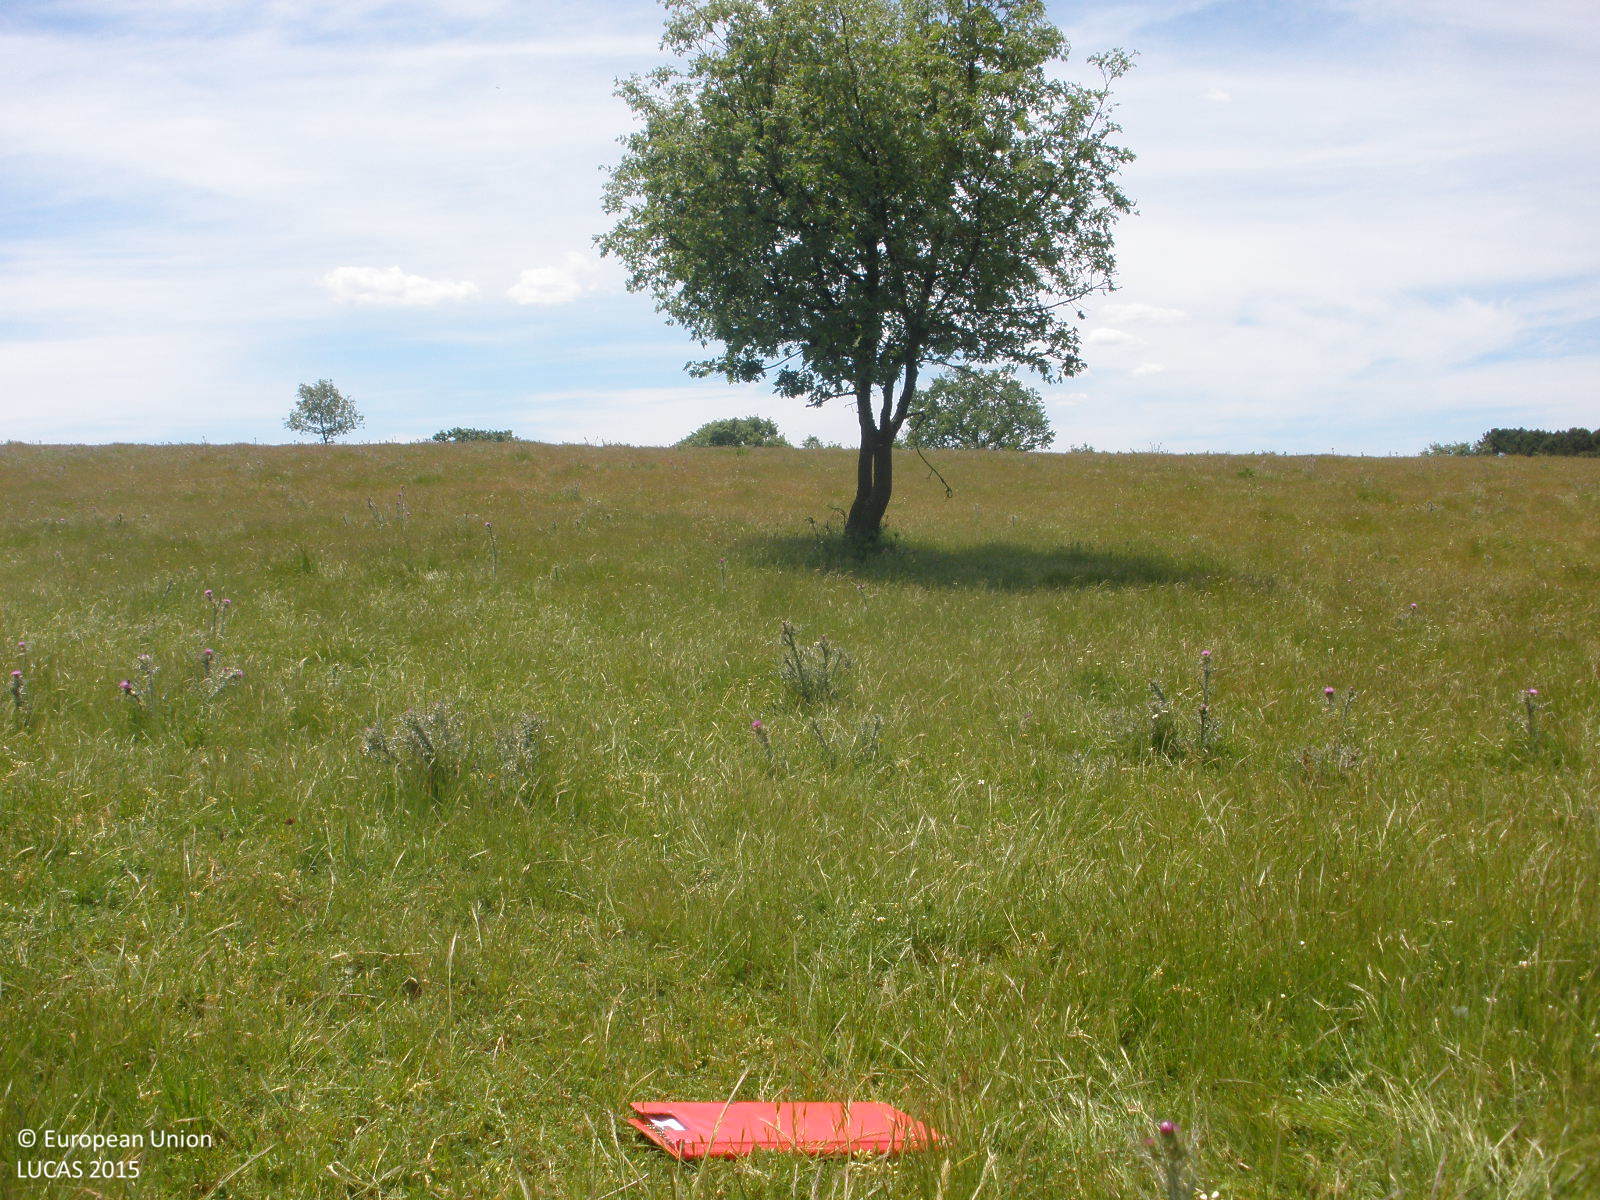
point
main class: Grassland
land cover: Grassland without tree/shrub cover
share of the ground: > 75 %
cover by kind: herbaceous plants 100 %
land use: Agriculture (excluding fallow land and kitchen gardens)
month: May
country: ES
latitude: 40.3691
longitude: -6.6109
